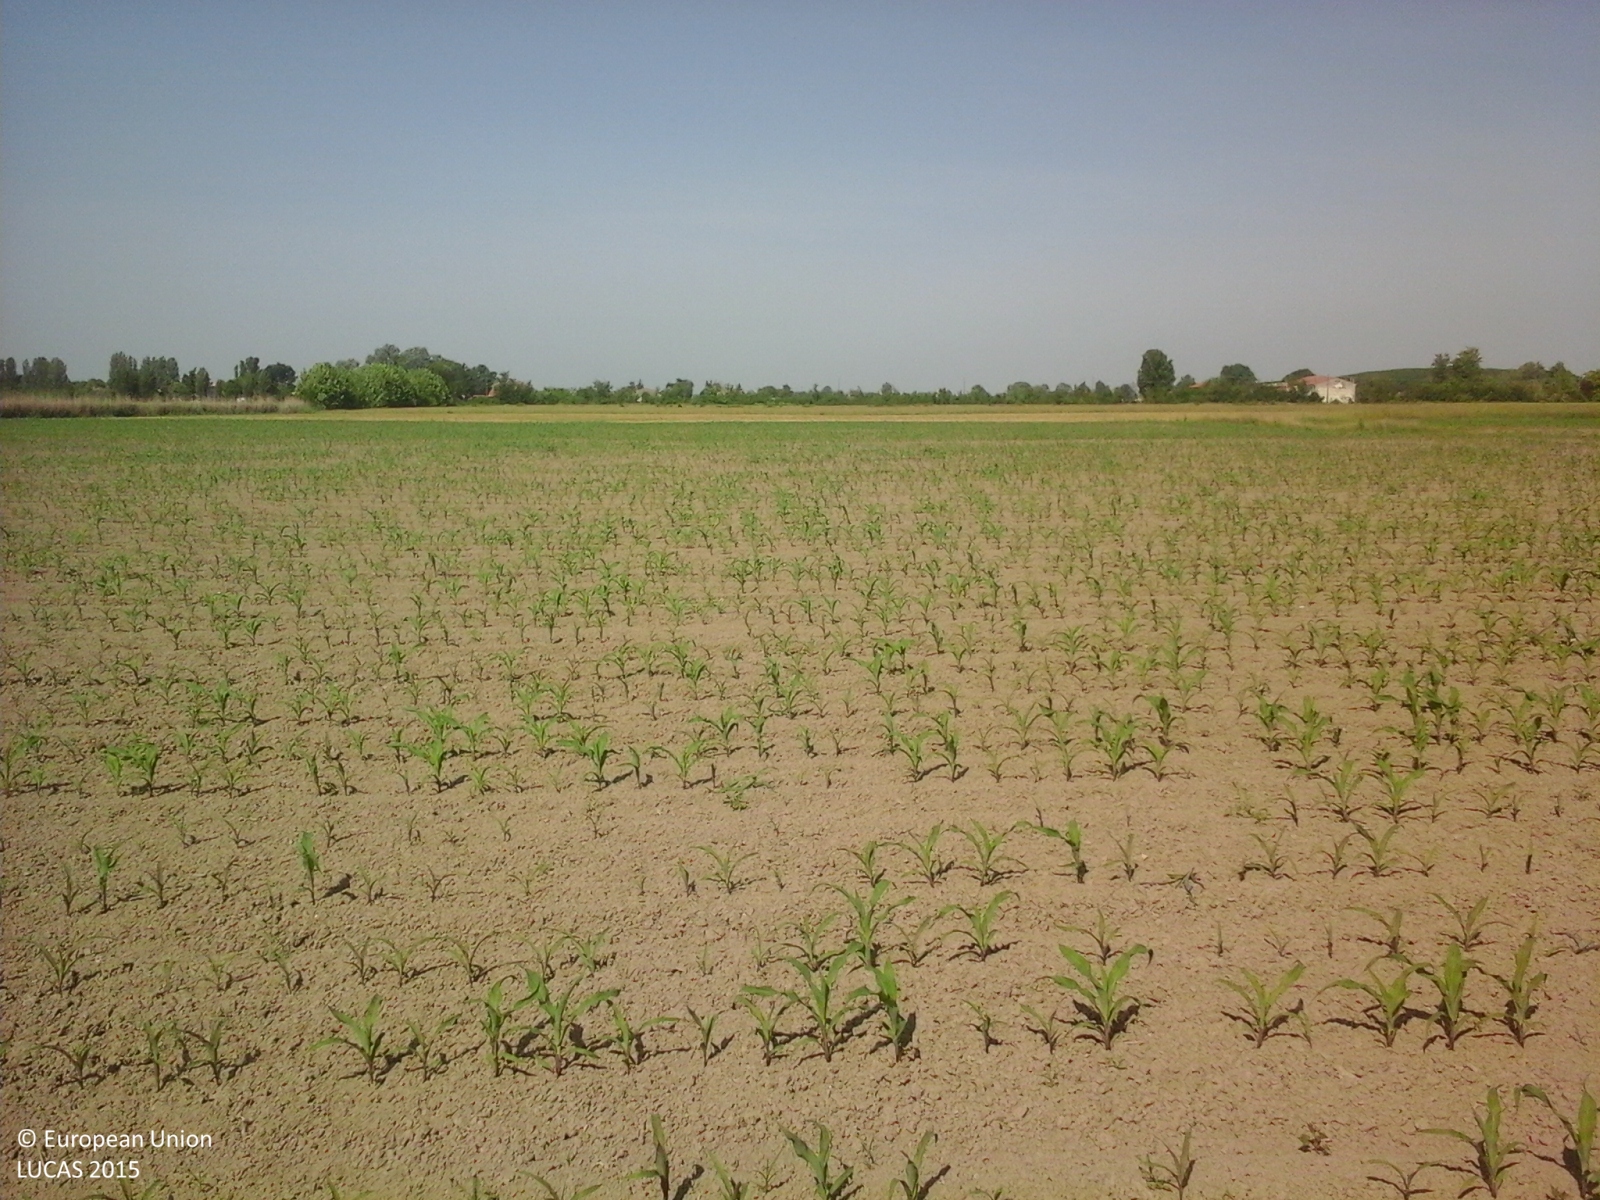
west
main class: Cropland
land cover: Maize
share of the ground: 10 - 25 %
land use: Agriculture (excluding fallow land and kitchen gardens)
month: May
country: IT
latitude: 45.0493
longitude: 10.9758
